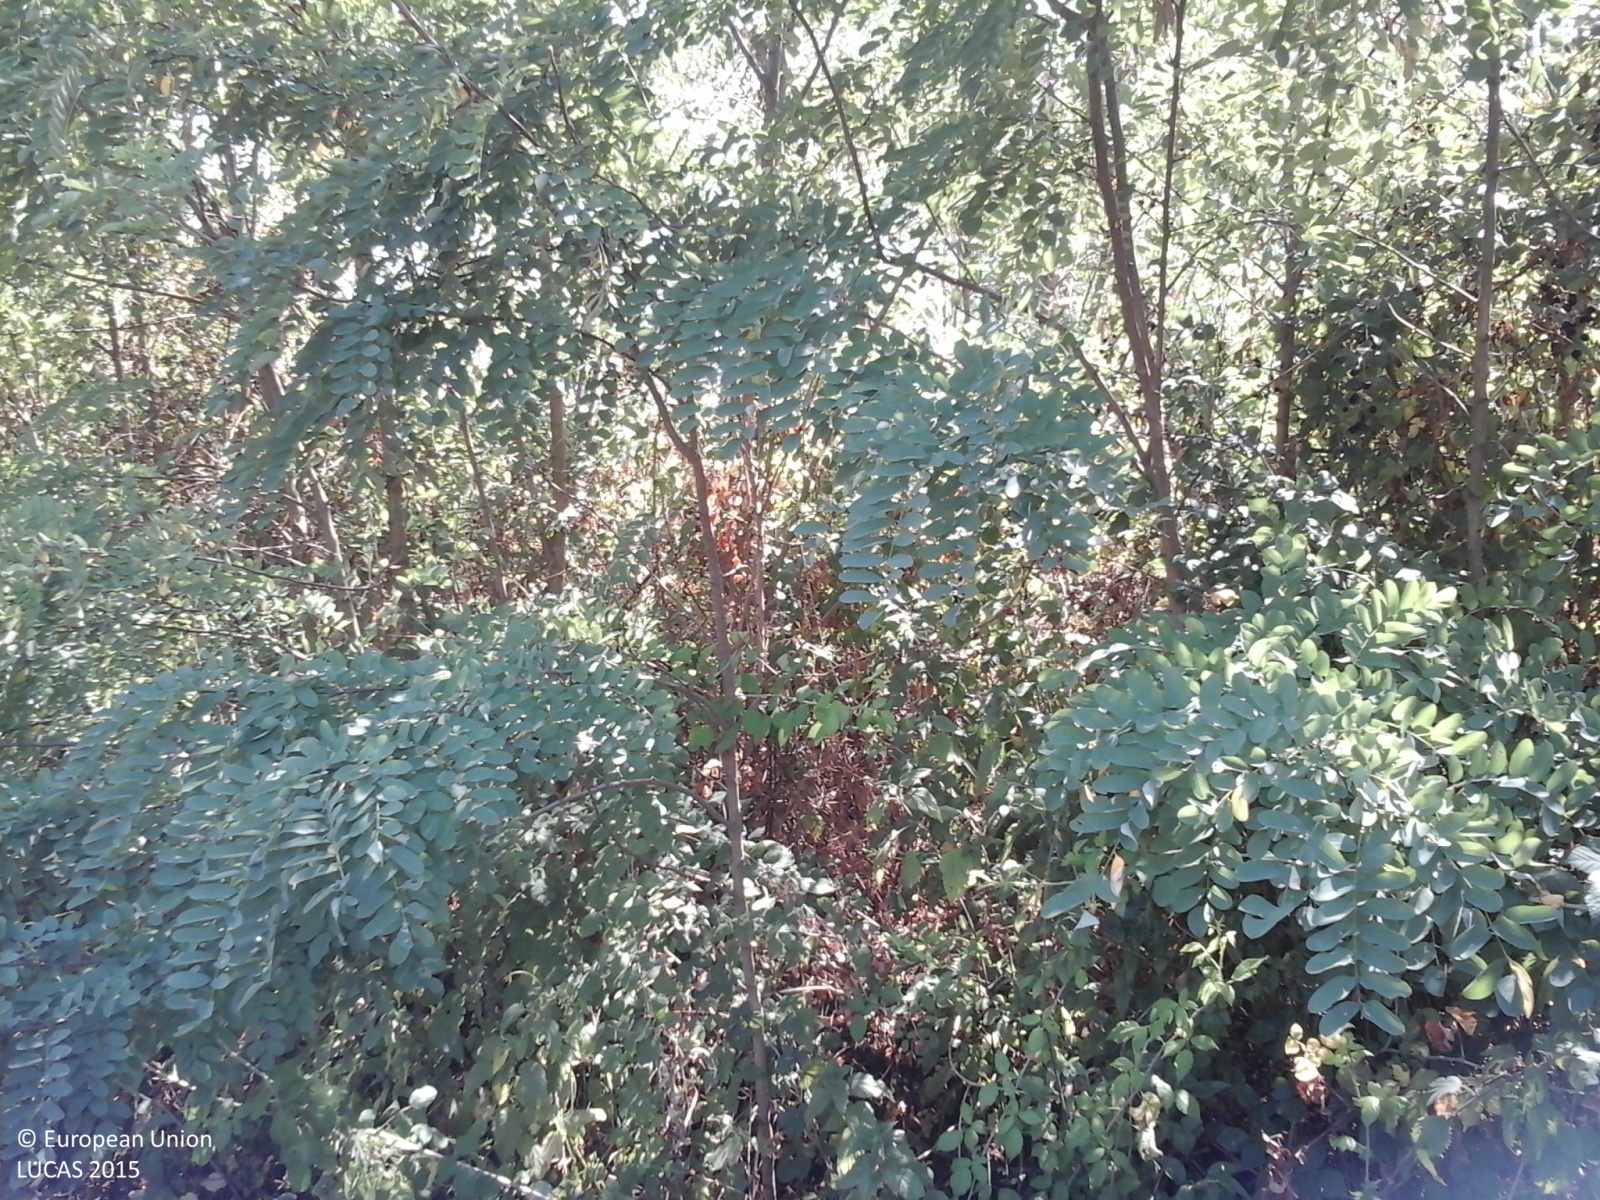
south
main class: Cropland
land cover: Other fruit trees and berries
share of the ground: 50 - 75 %
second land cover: Other bare soil
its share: > 75 %
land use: Agriculture (excluding fallow land and kitchen gardens)
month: July
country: IT
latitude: 41.5256
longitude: 12.9724
